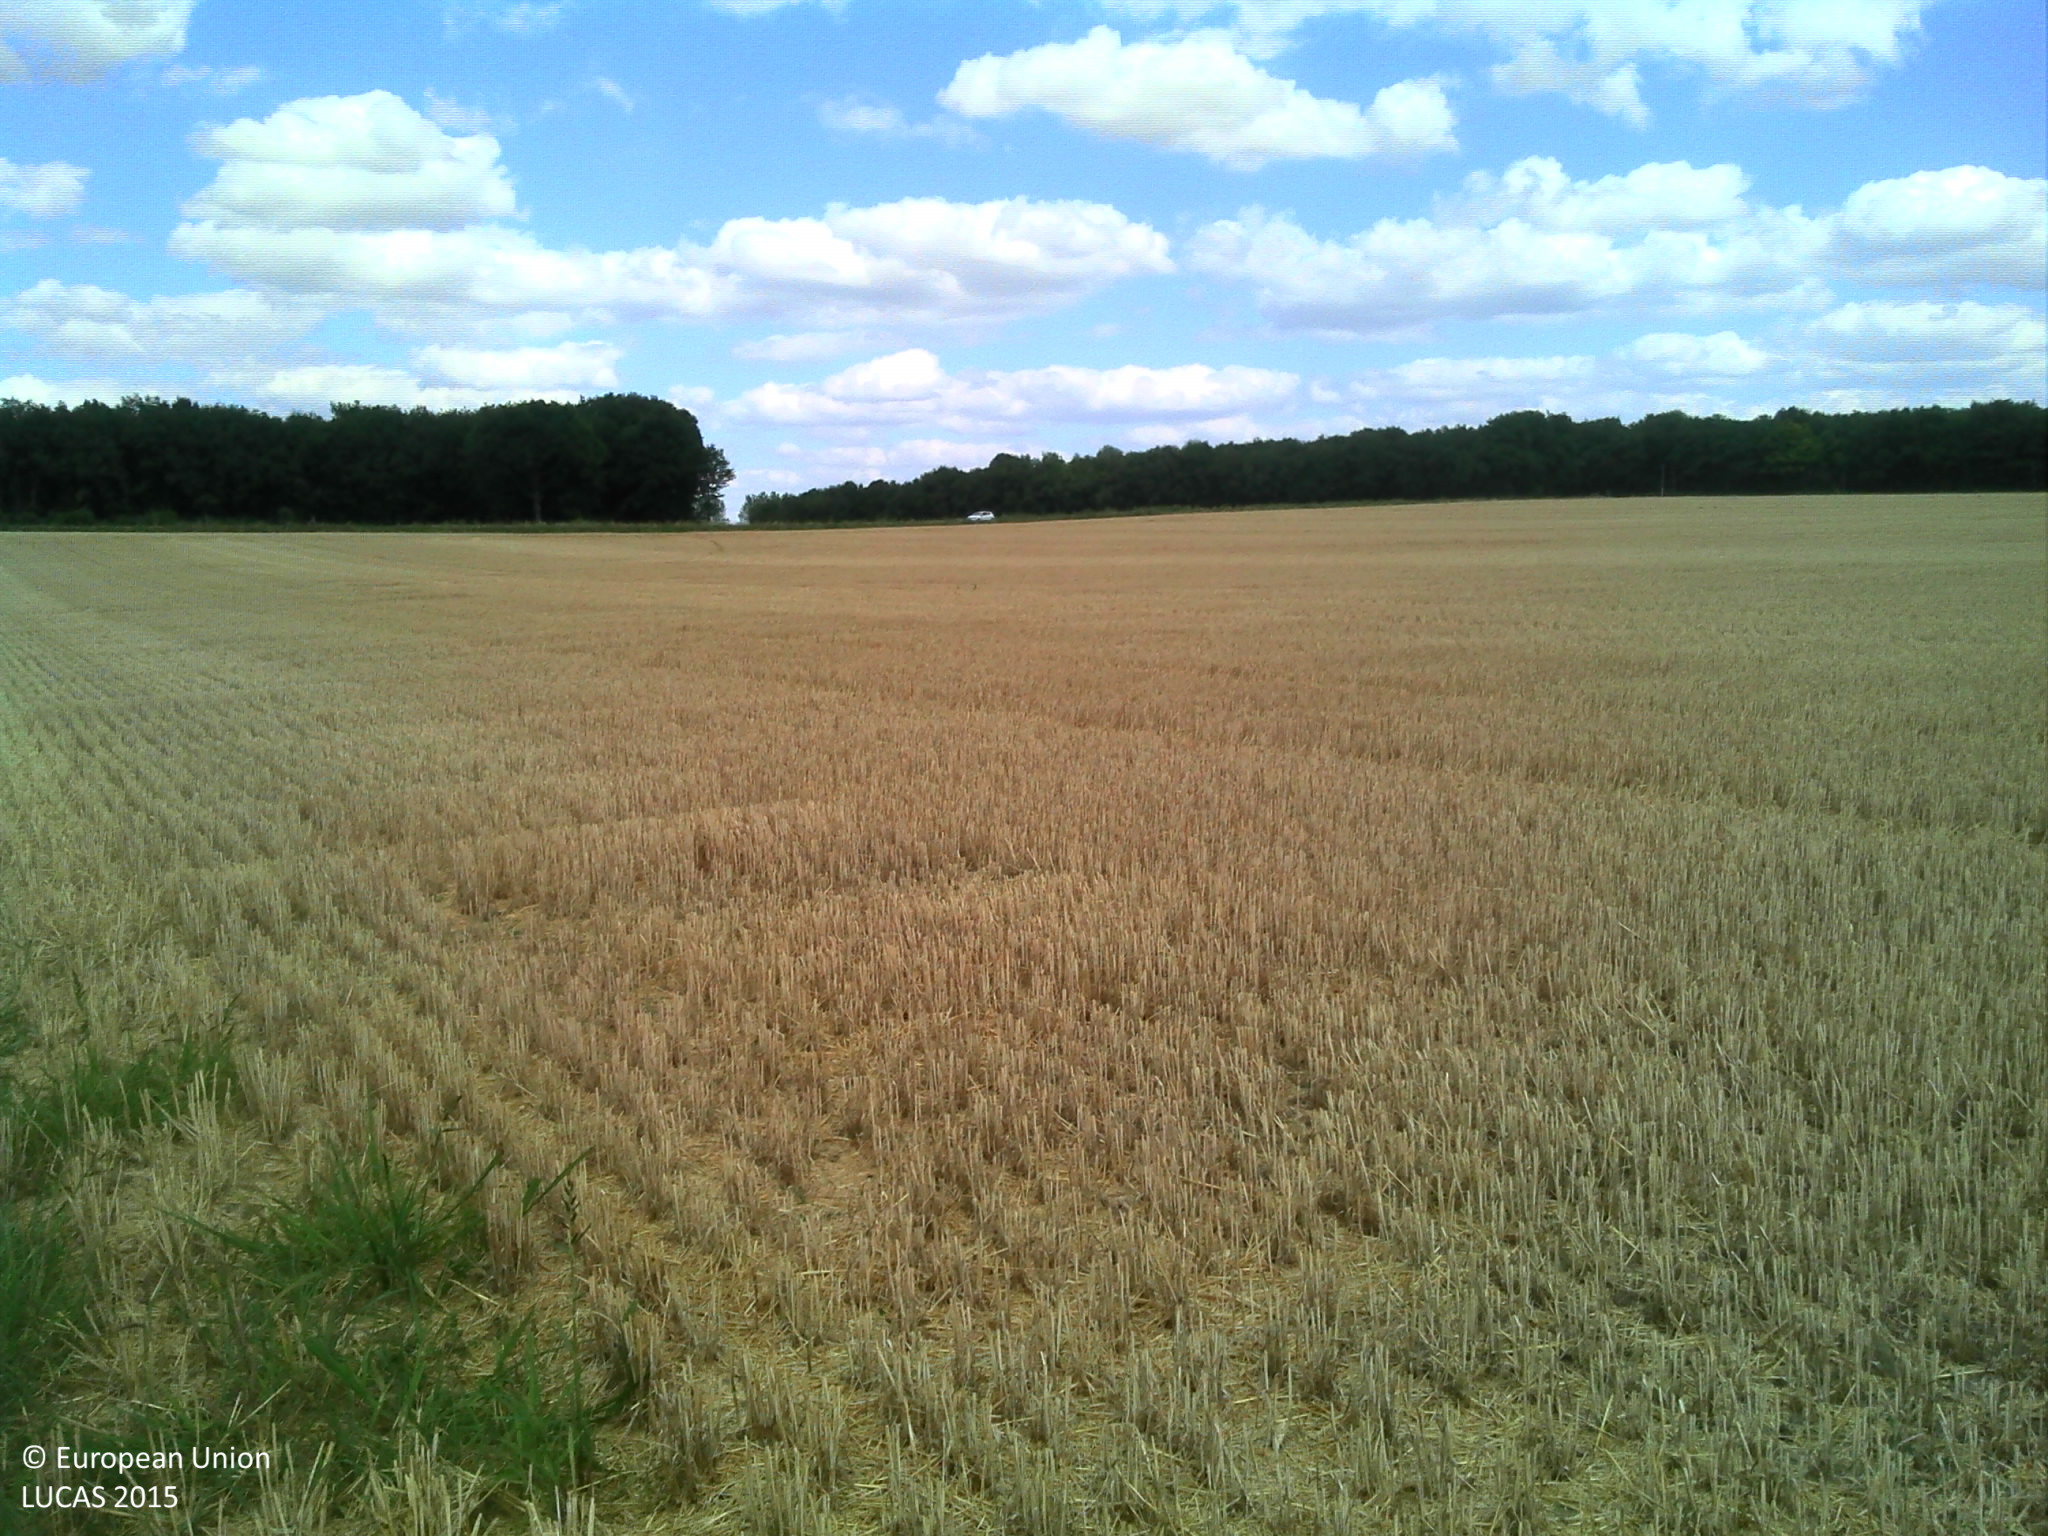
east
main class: Cropland
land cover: Common wheat
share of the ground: > 75 %
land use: Agriculture (excluding fallow land and kitchen gardens)
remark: Harvested field
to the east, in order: Common wheat
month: July
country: FR
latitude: 47.0620
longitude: 0.8323
